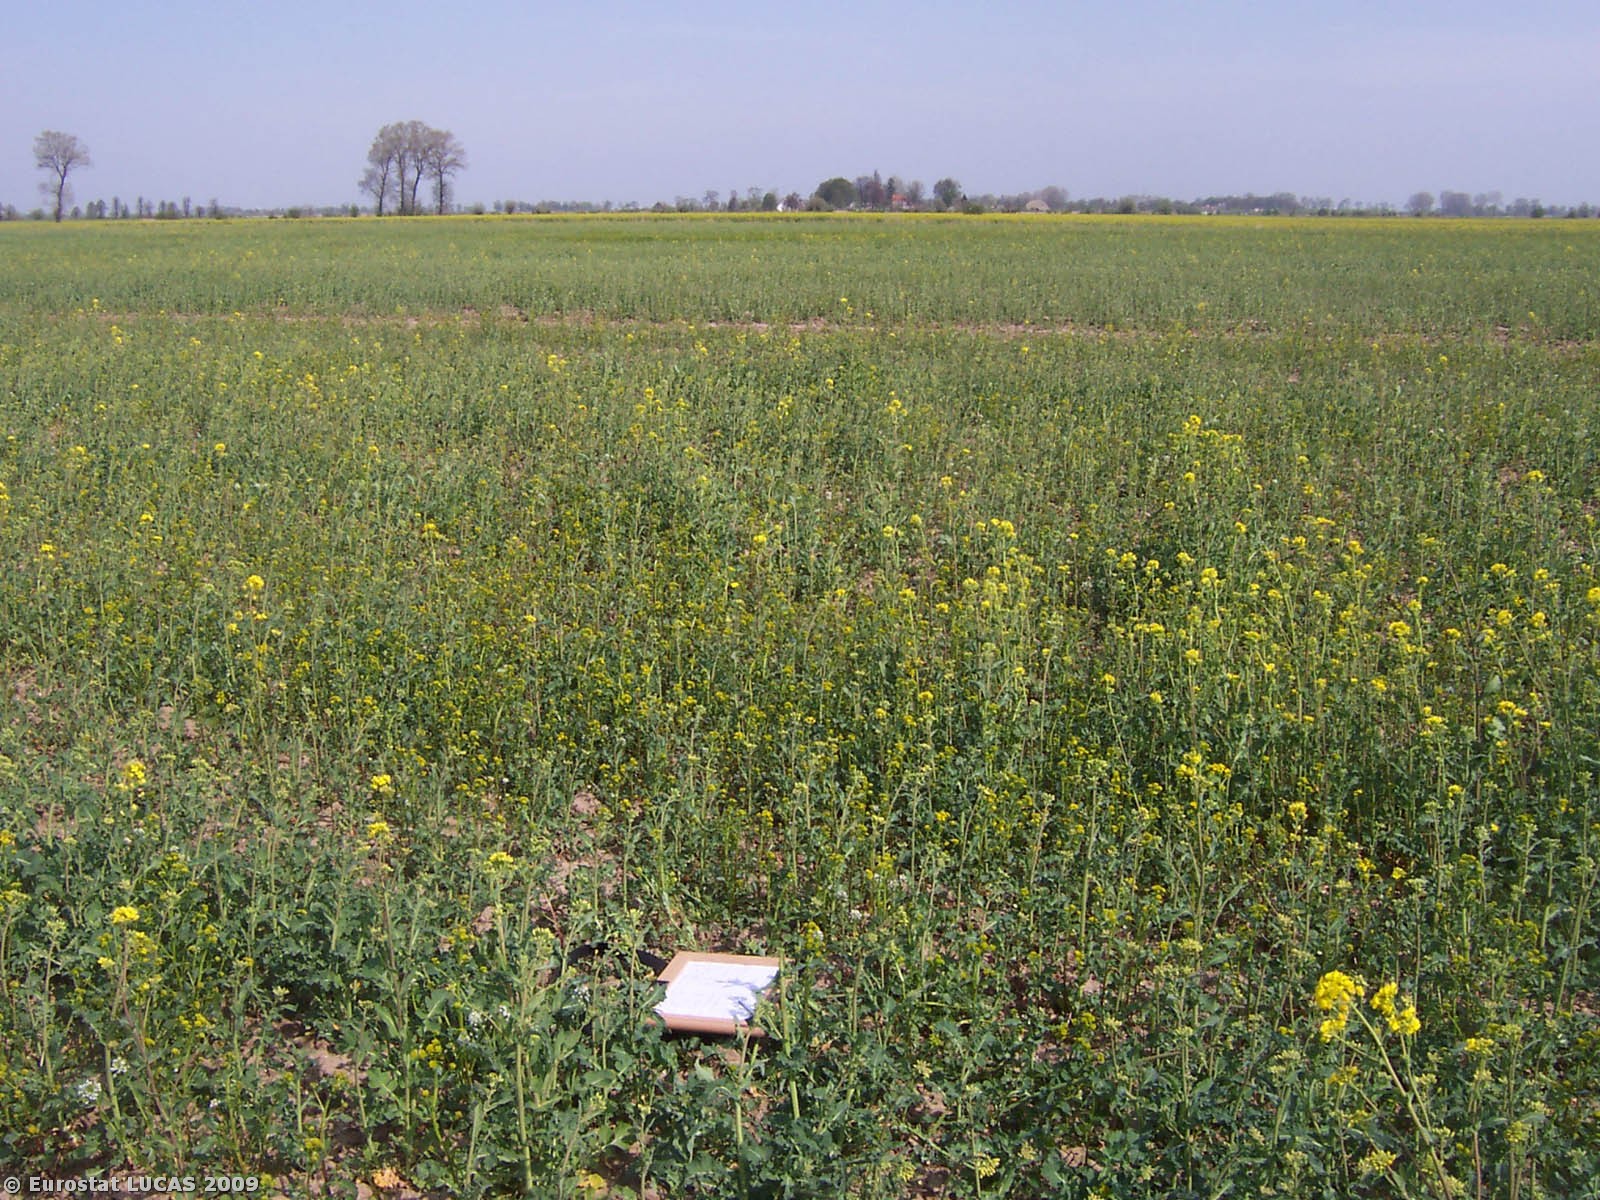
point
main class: Cropland
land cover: Rape and turnip rape
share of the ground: 50 - 75 %
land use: Agriculture (excluding fallow land and kitchen gardens)
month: April
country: PL
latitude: 54.1712
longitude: 18.9826
